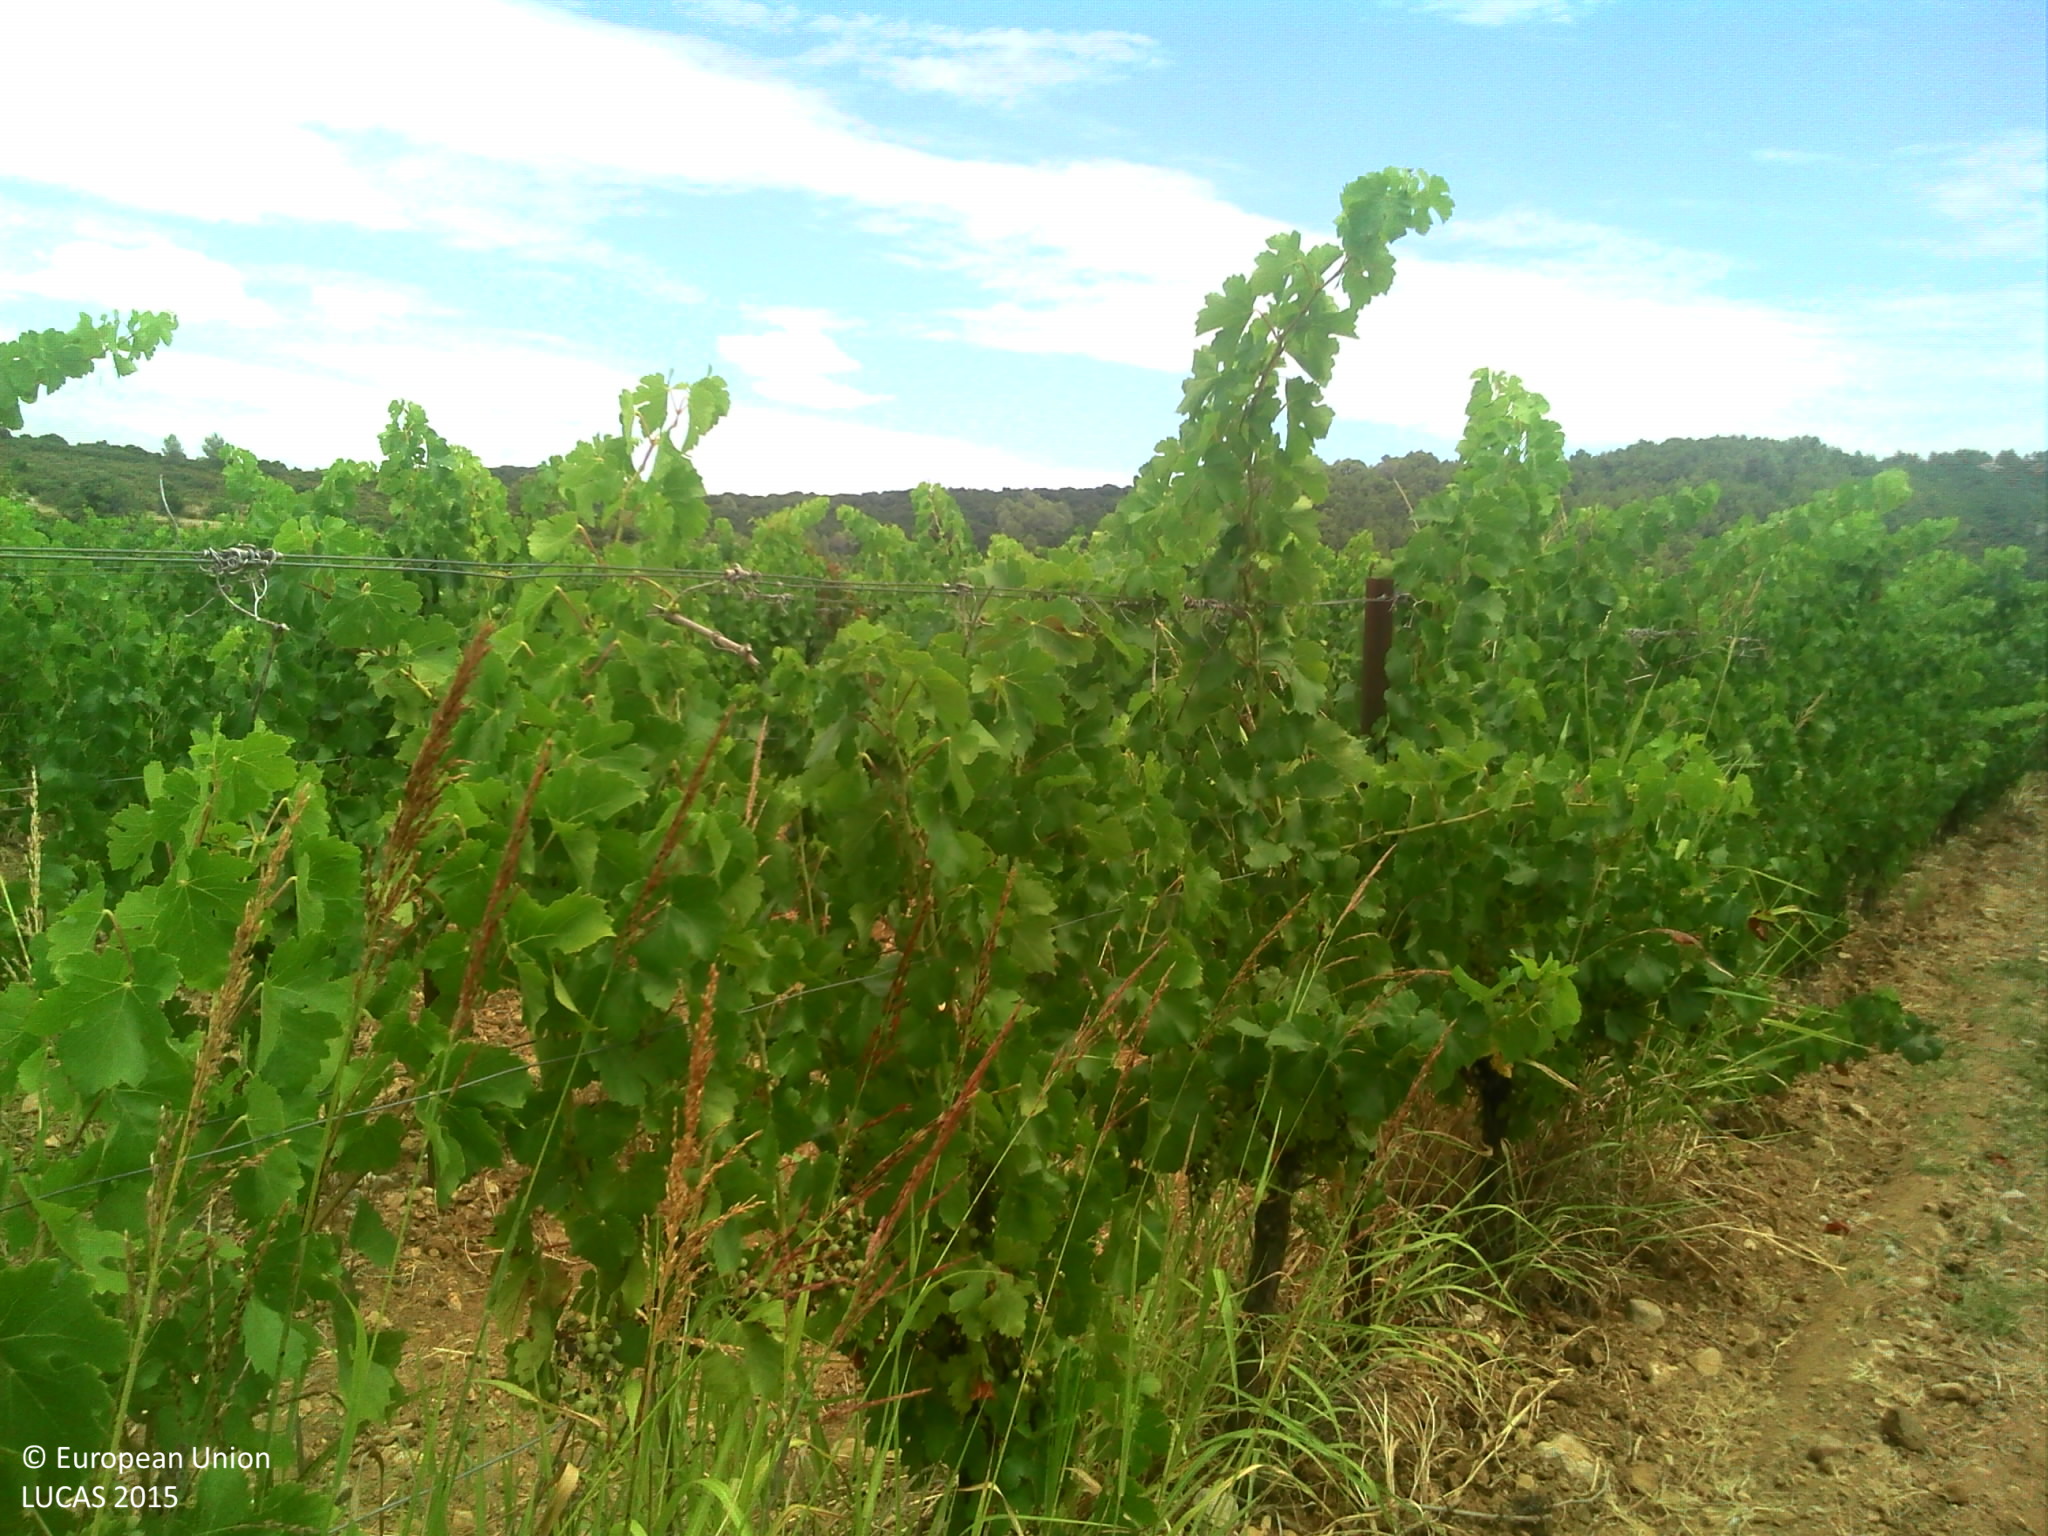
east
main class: Cropland
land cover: Vineyards
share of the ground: 25 - 50 %
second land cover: Other bare soil
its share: > 75 %
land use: Agriculture (excluding fallow land and kitchen gardens)
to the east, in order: Vineyards; Other bare soil; Tracks; Vineyards; Tracks; Shrubland with sparse tree cover; Tracks; Vineyards; Tracks; Vineyards
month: July
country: FR
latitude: 43.4494
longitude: 3.0763
